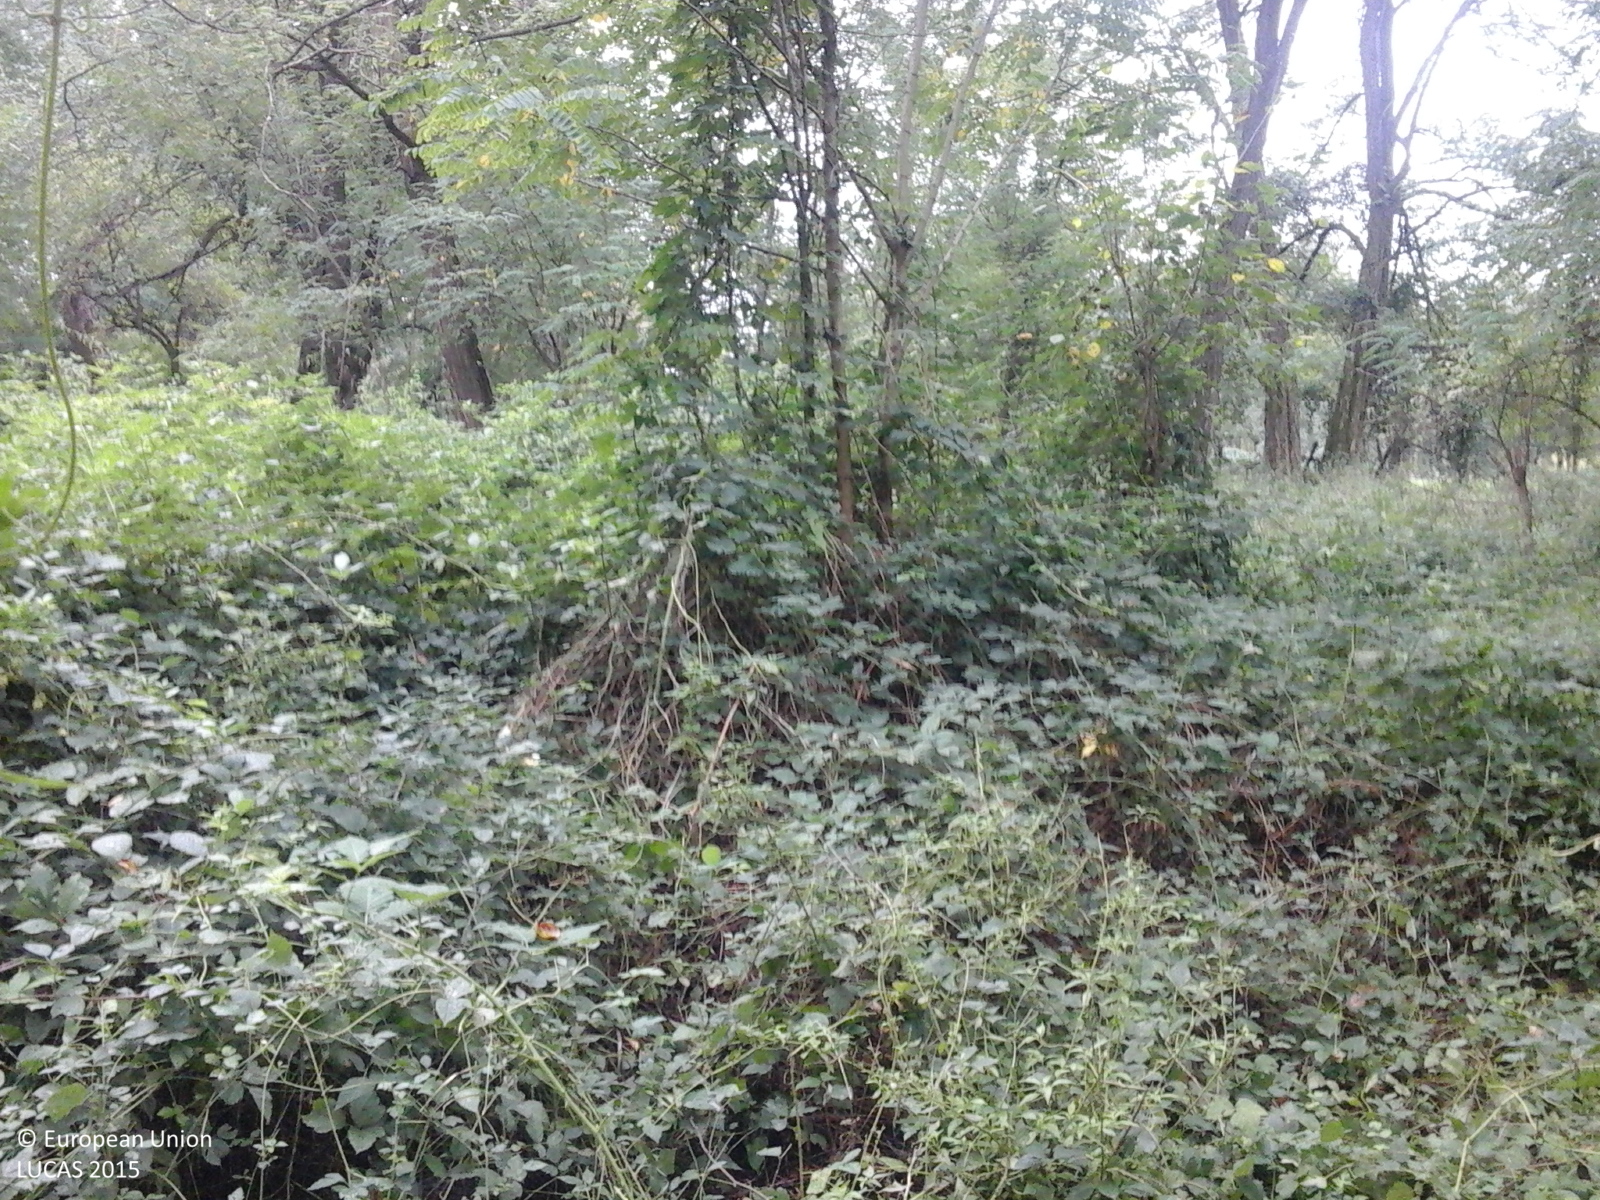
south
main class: Woodland
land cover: Broadleaved woodland
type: acidophilous oak and oak-birch forest
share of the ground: > 75 %
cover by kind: broadleaved forest trees 100 %
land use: Forestry
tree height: > 5 m
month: September
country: RO
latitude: 45.1228
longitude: 23.2374
